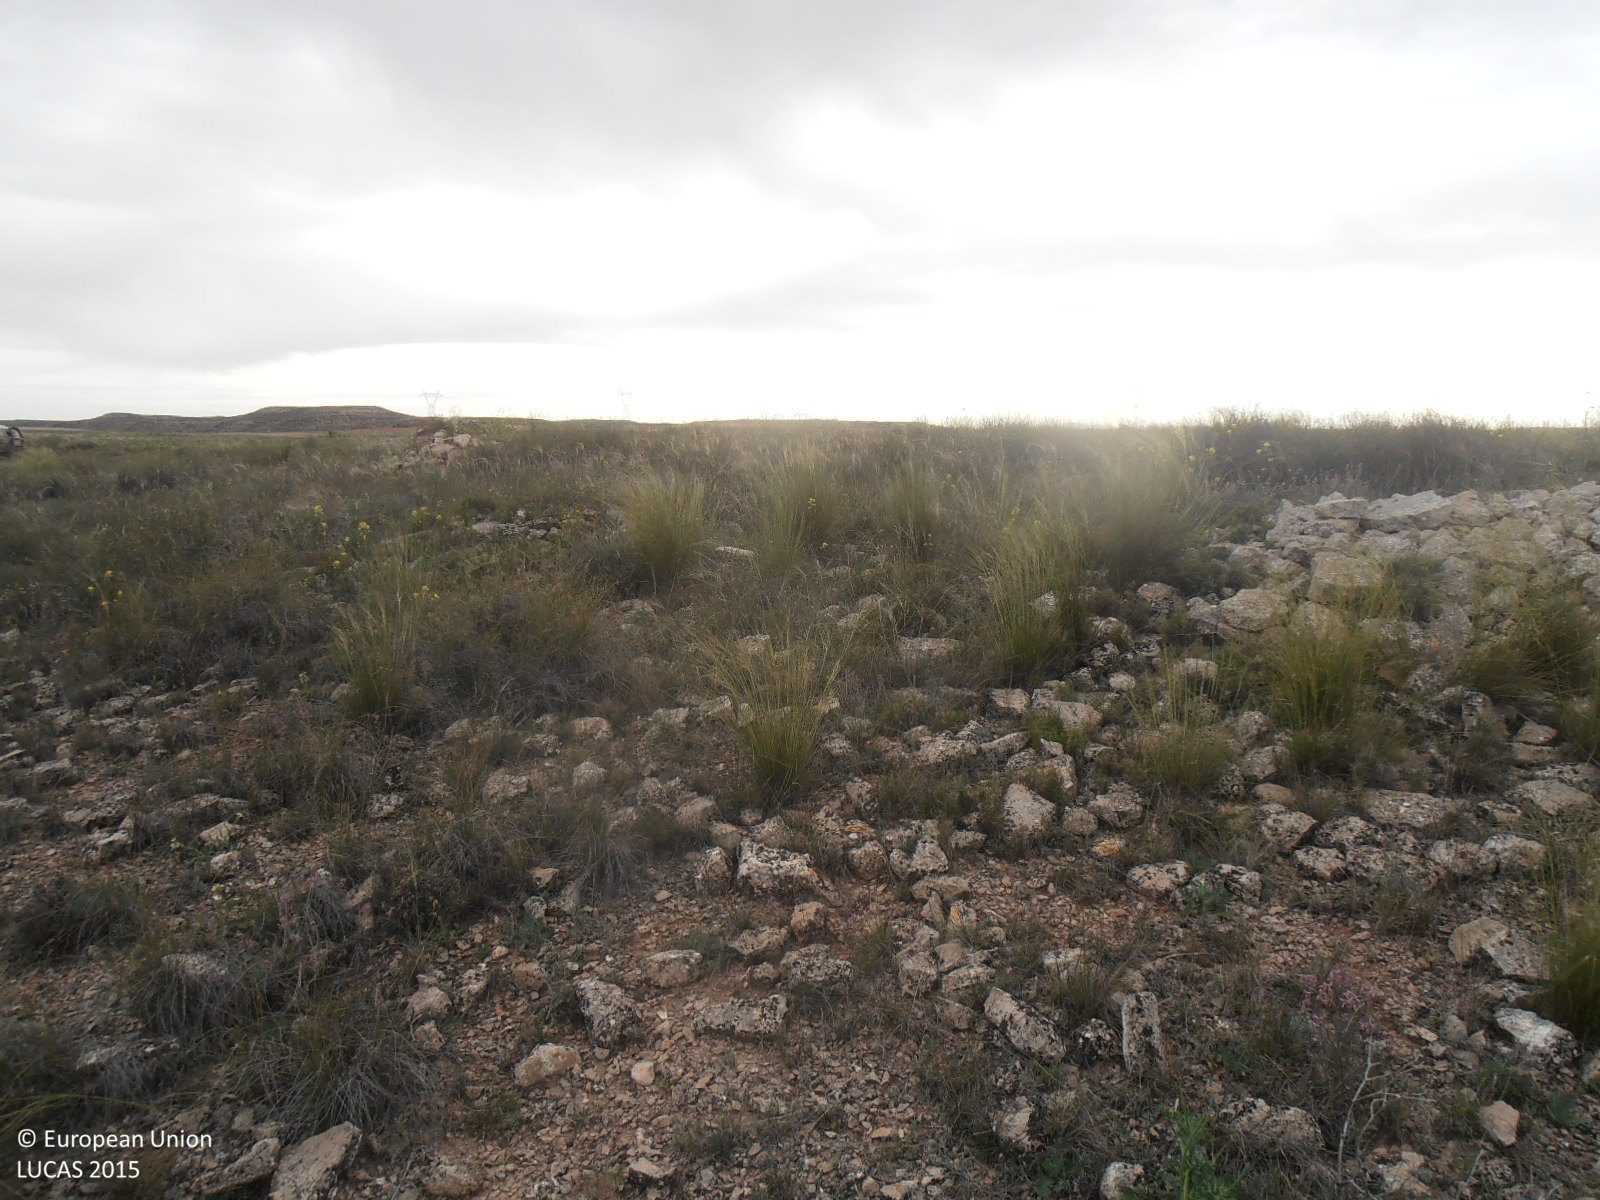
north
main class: Grassland
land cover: Grassland without tree/shrub cover
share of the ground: > 75 %
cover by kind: herbaceous plants 65 %, consolidated bare surface 30 %, shrubs 5 %
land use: Semi-natural and natural areas not in use
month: April
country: ES
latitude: 41.4087
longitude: -0.3878
